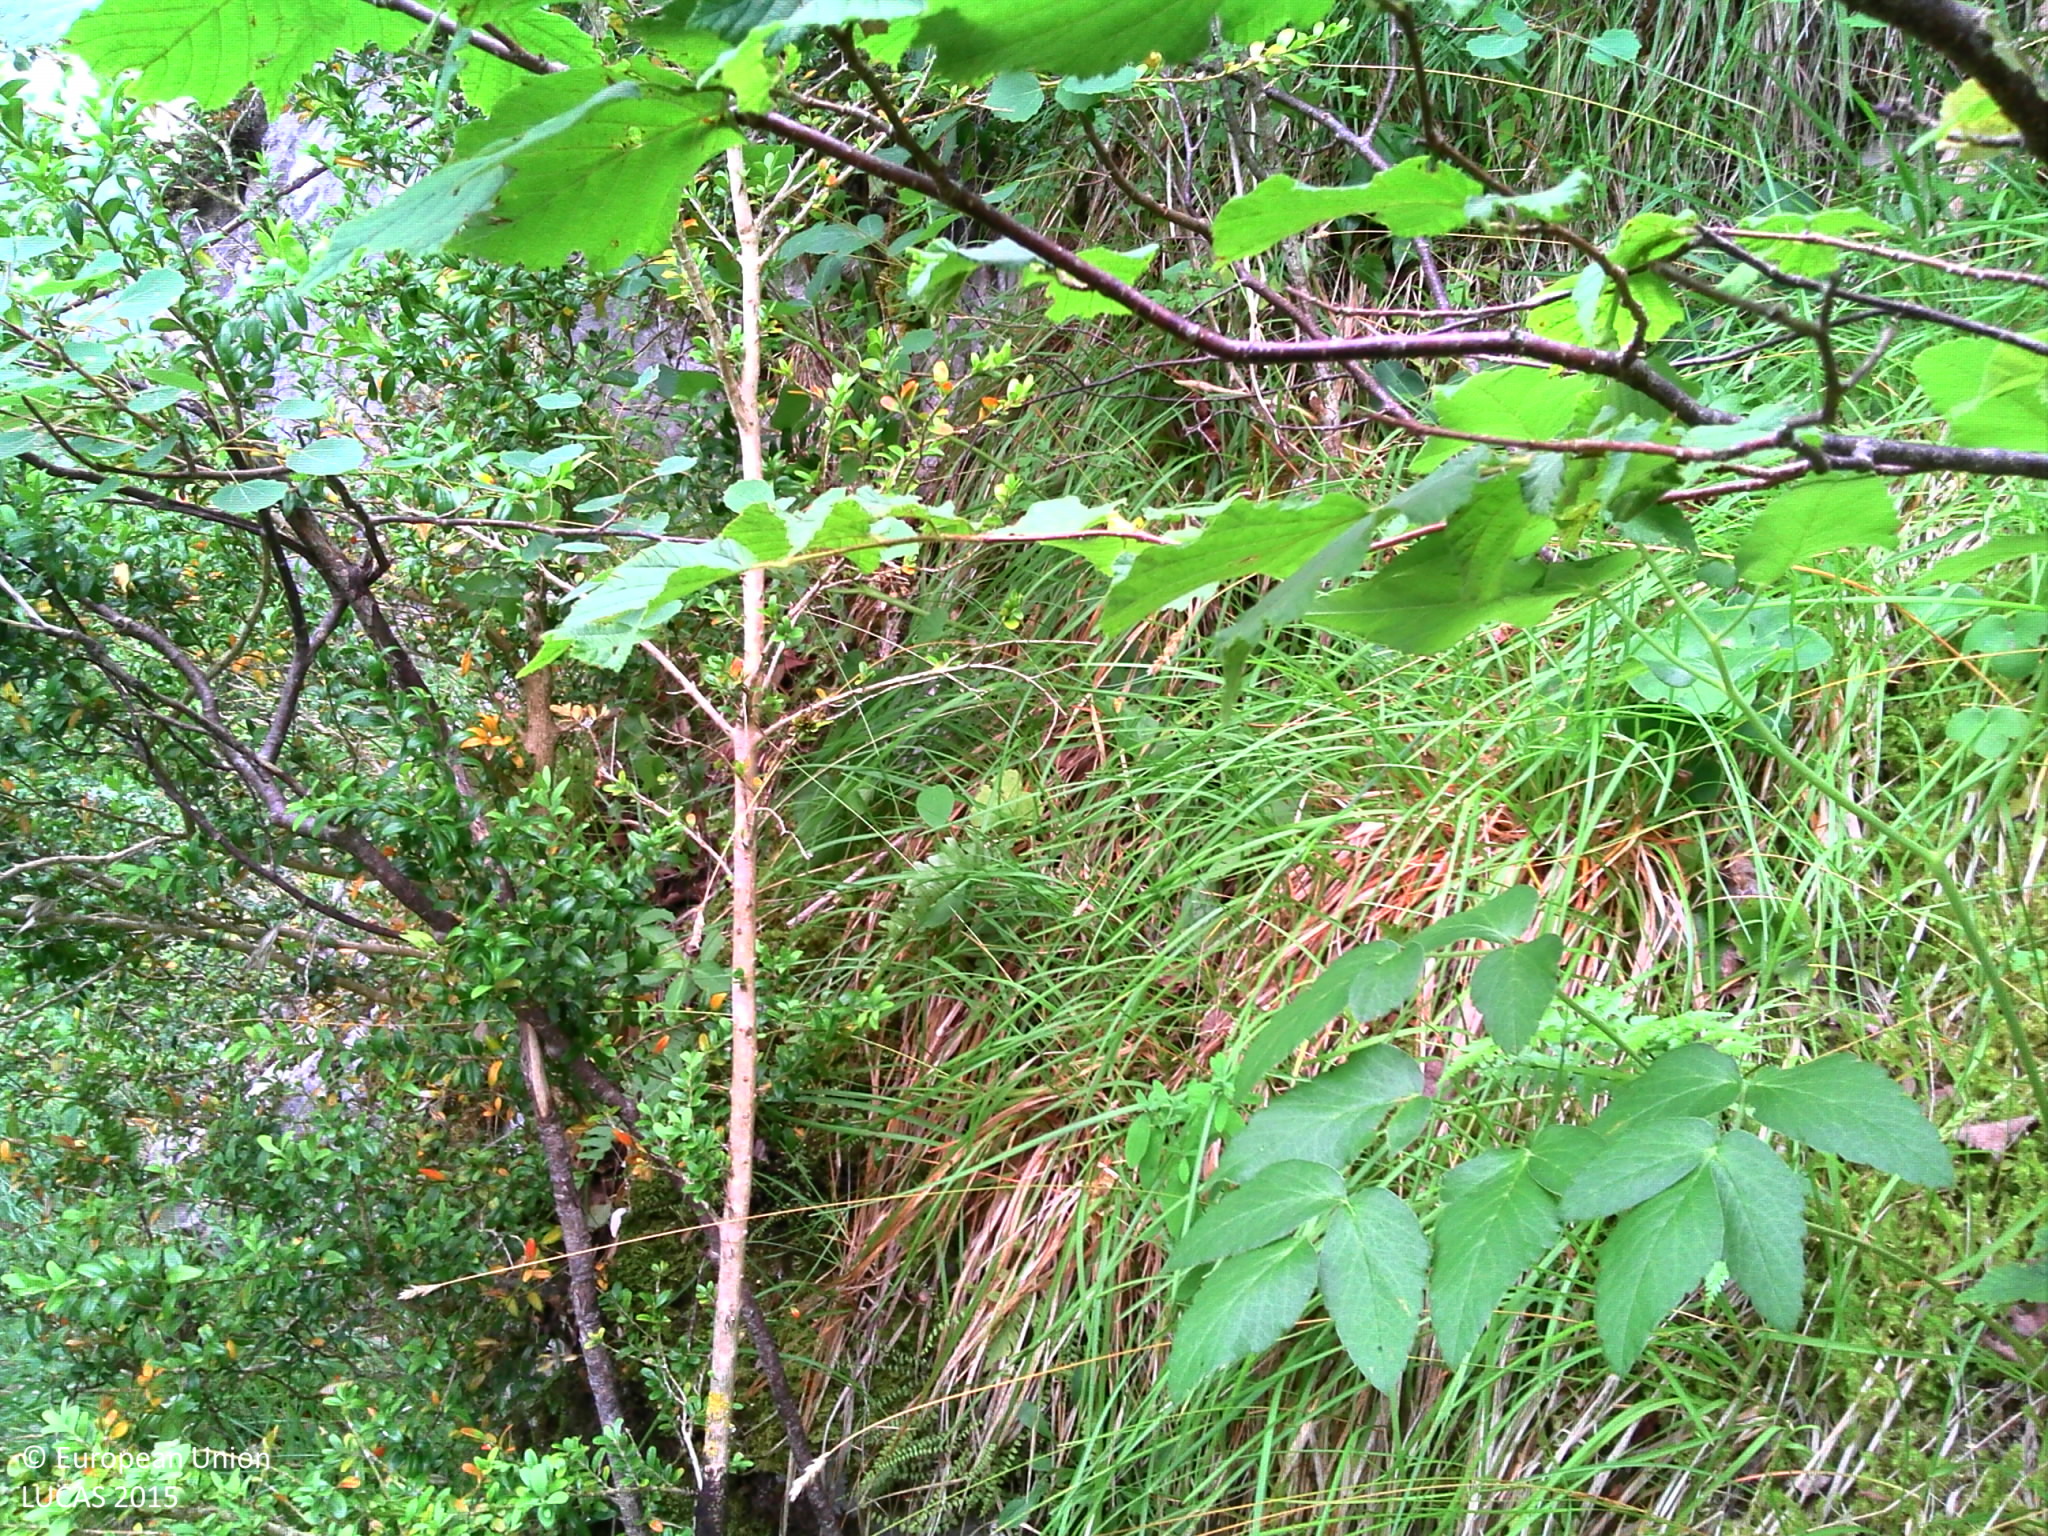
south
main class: Woodland
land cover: Broadleaved woodland
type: mountainous beech forest
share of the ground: > 75 %
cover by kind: broadleaved forest trees 50 %, shrubs 30 %, herbaceous plants 10 %, consolidated bare surface 10 %
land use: Semi-natural and natural areas not in use
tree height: > 5 m
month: July
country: FR
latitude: 42.9249
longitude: 0.8023
